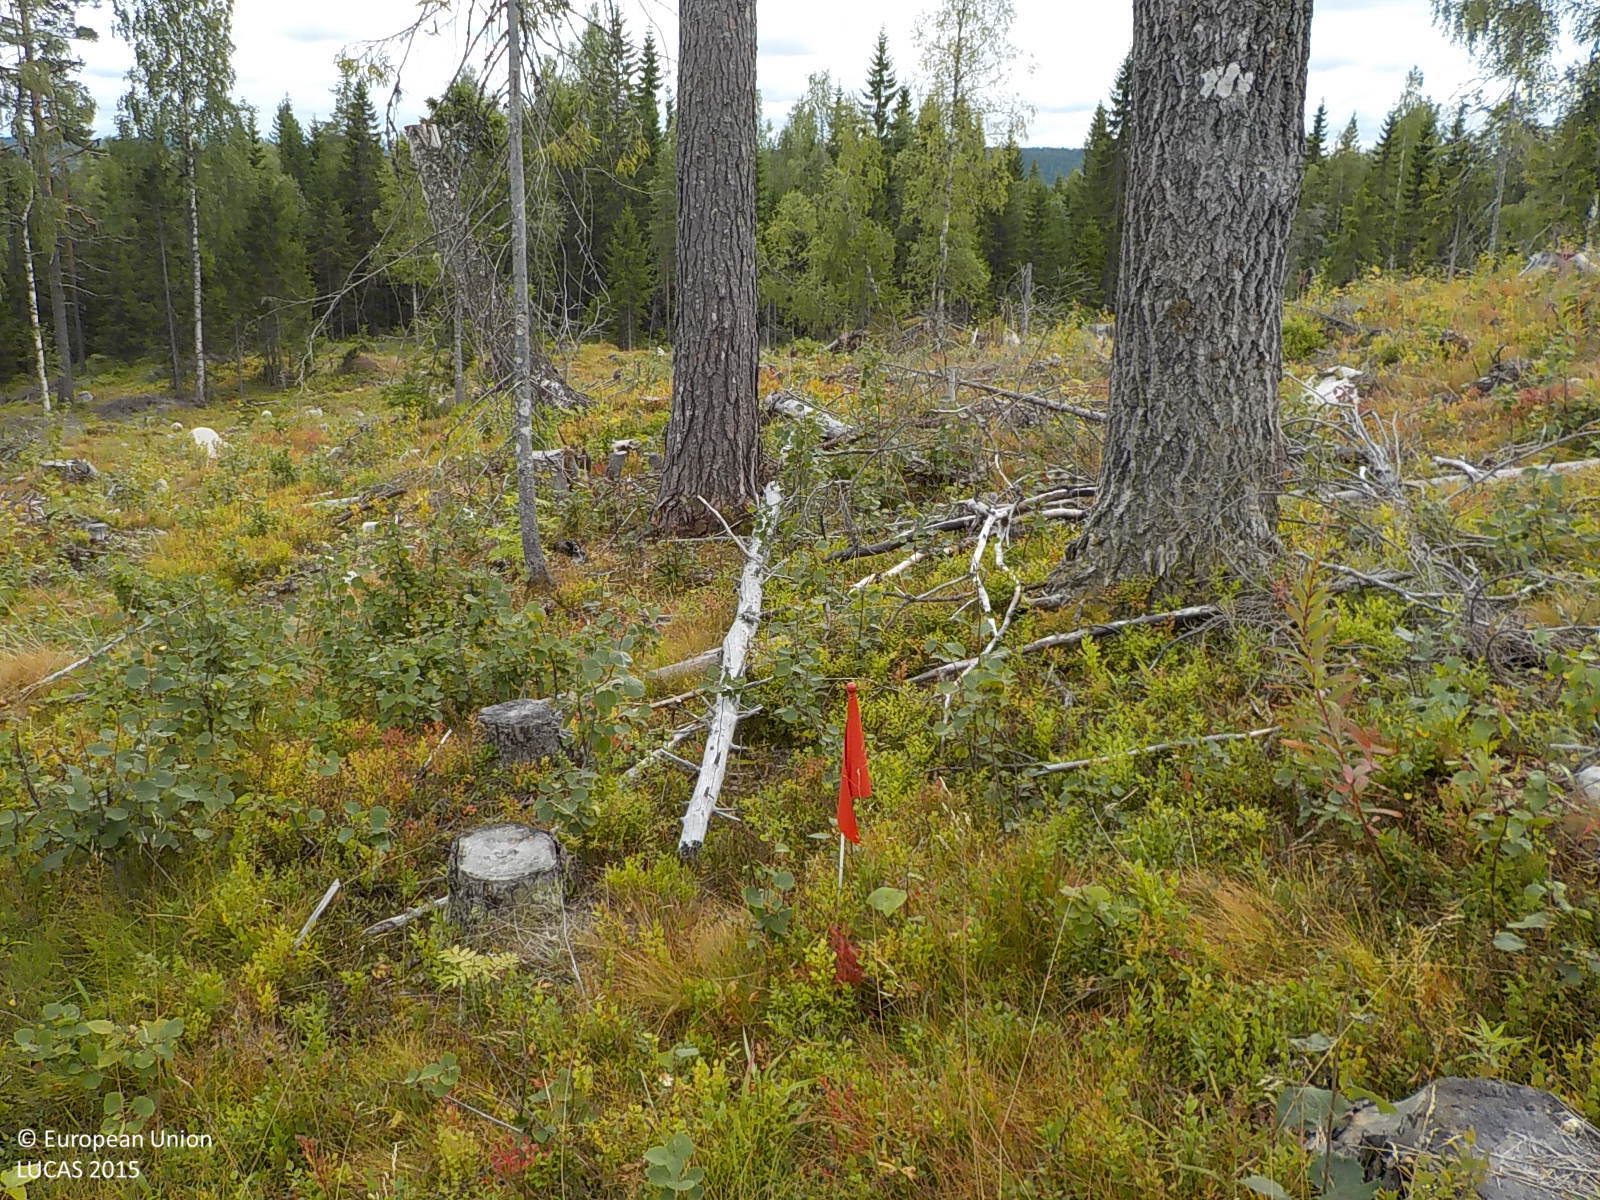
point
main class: Woodland
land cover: Spruce dominated coniferous woodland
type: boreal forest
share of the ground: 10 - 25 %
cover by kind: shrubs 30 %, herbaceous plants 30 %, coniferous forest trees 20 %, lichens and mosses 15 %, broadleaved forest trees 5 %
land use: Forestry
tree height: < 5 m
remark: Clear cut
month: September
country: SE
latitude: 63.3318
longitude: 17.8640
